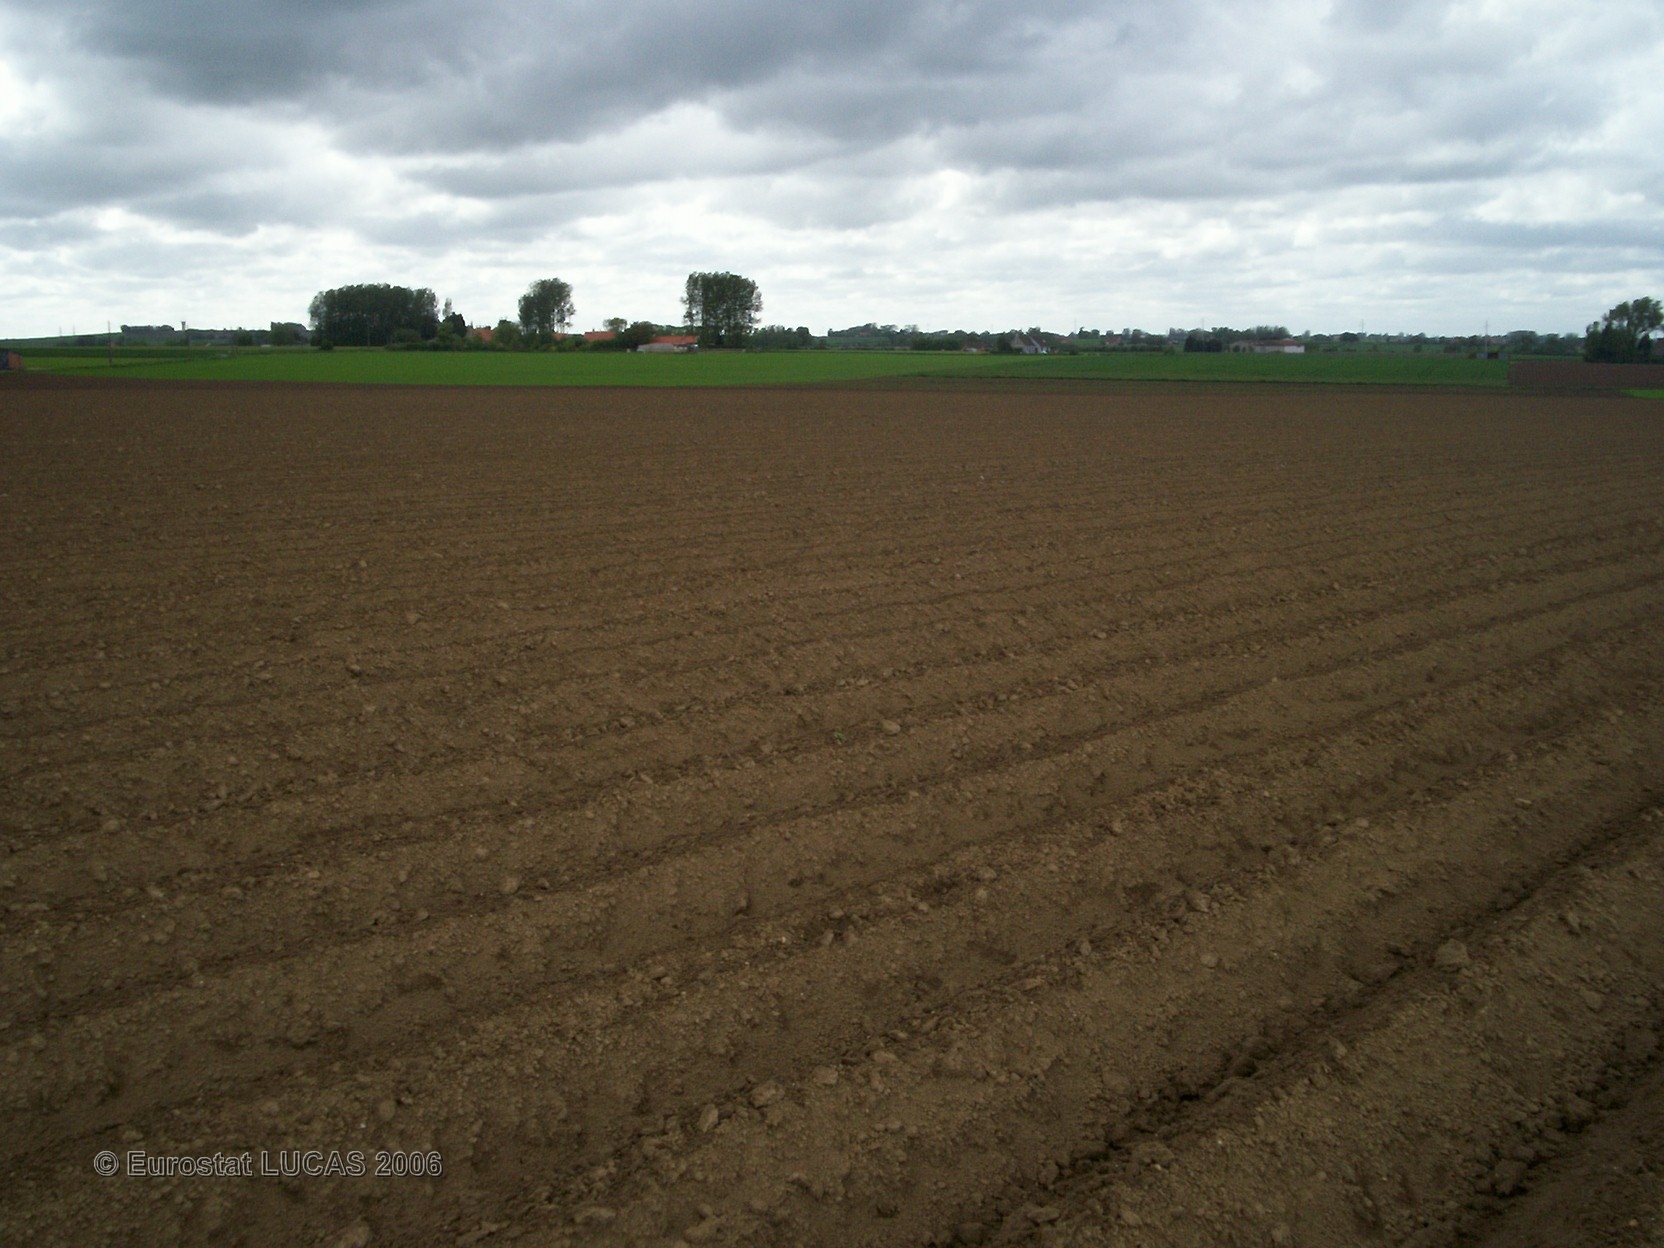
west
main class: Cropland
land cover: Potatoes
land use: Agriculture (excluding fallow land and kitchen gardens)
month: May
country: FR
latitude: 50.8168
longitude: 2.4215
